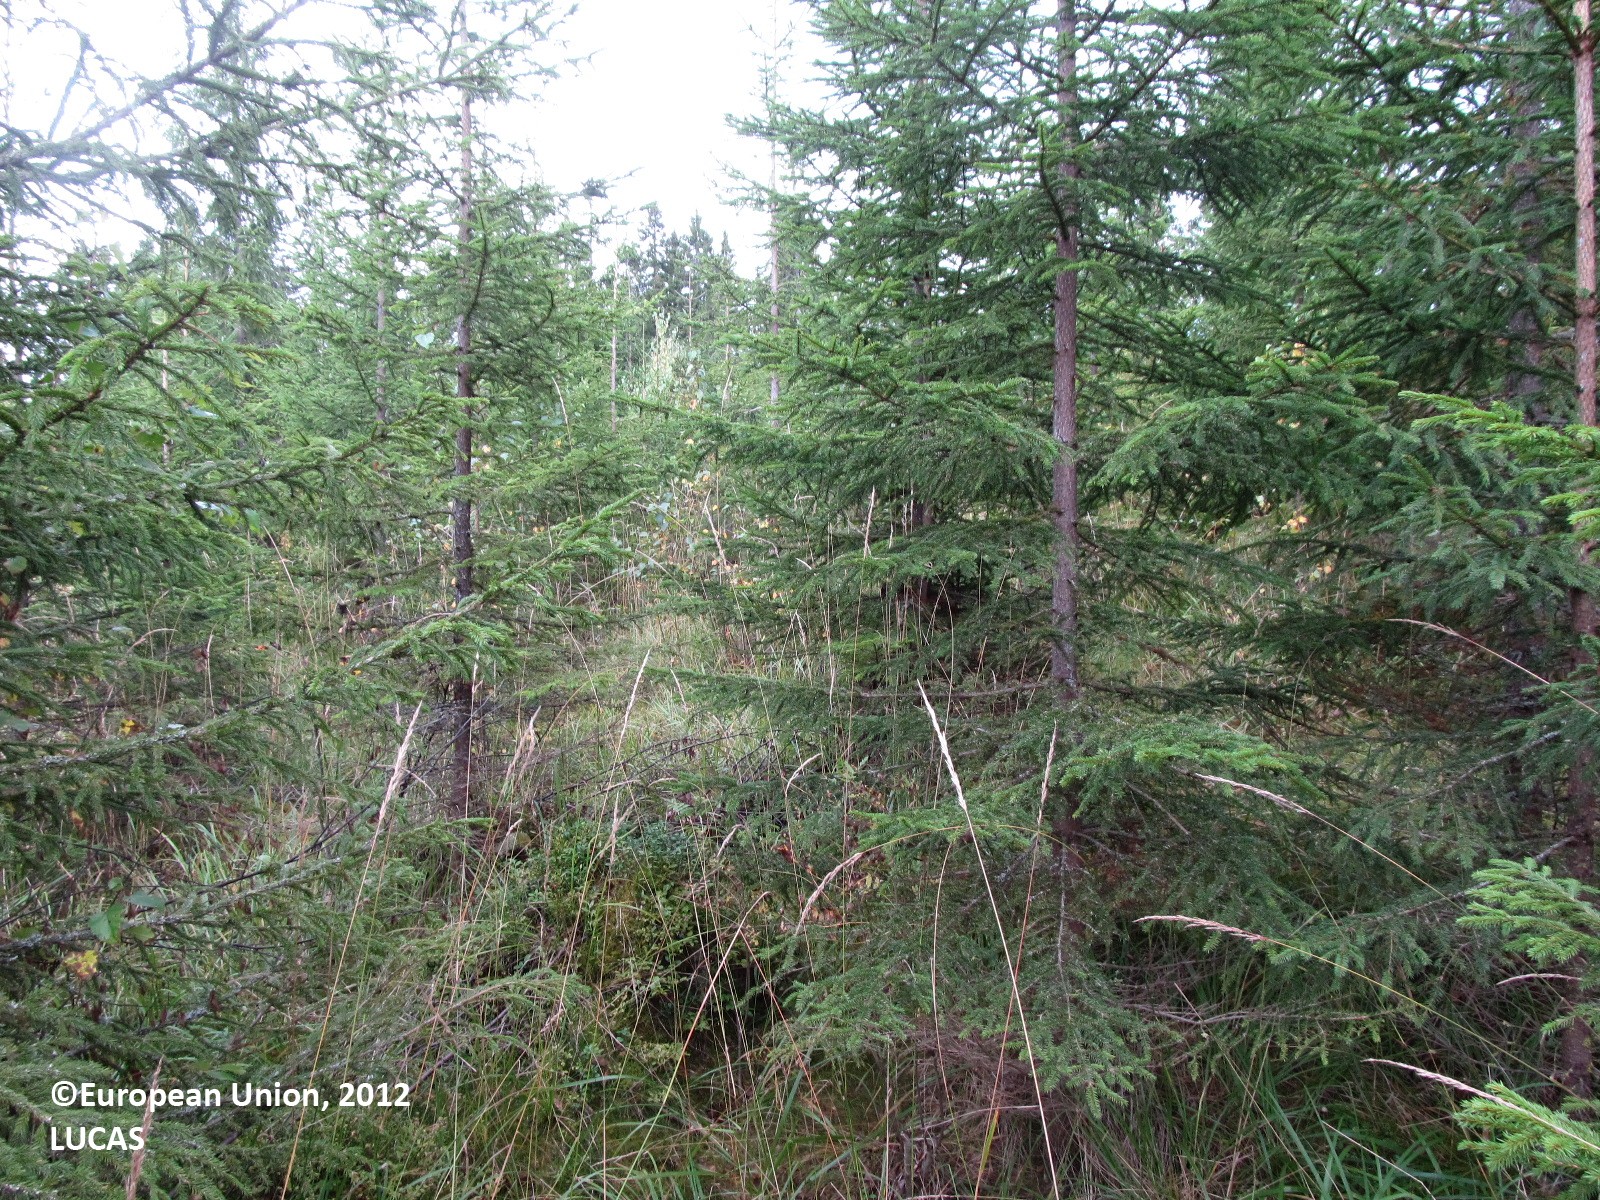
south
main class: Woodland
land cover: Spruce dominated coniferous woodland
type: boreal forest
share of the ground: 50 - 75 %
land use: Forestry
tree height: > 5 m
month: September
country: FI
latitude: 62.6787
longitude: 28.4982
